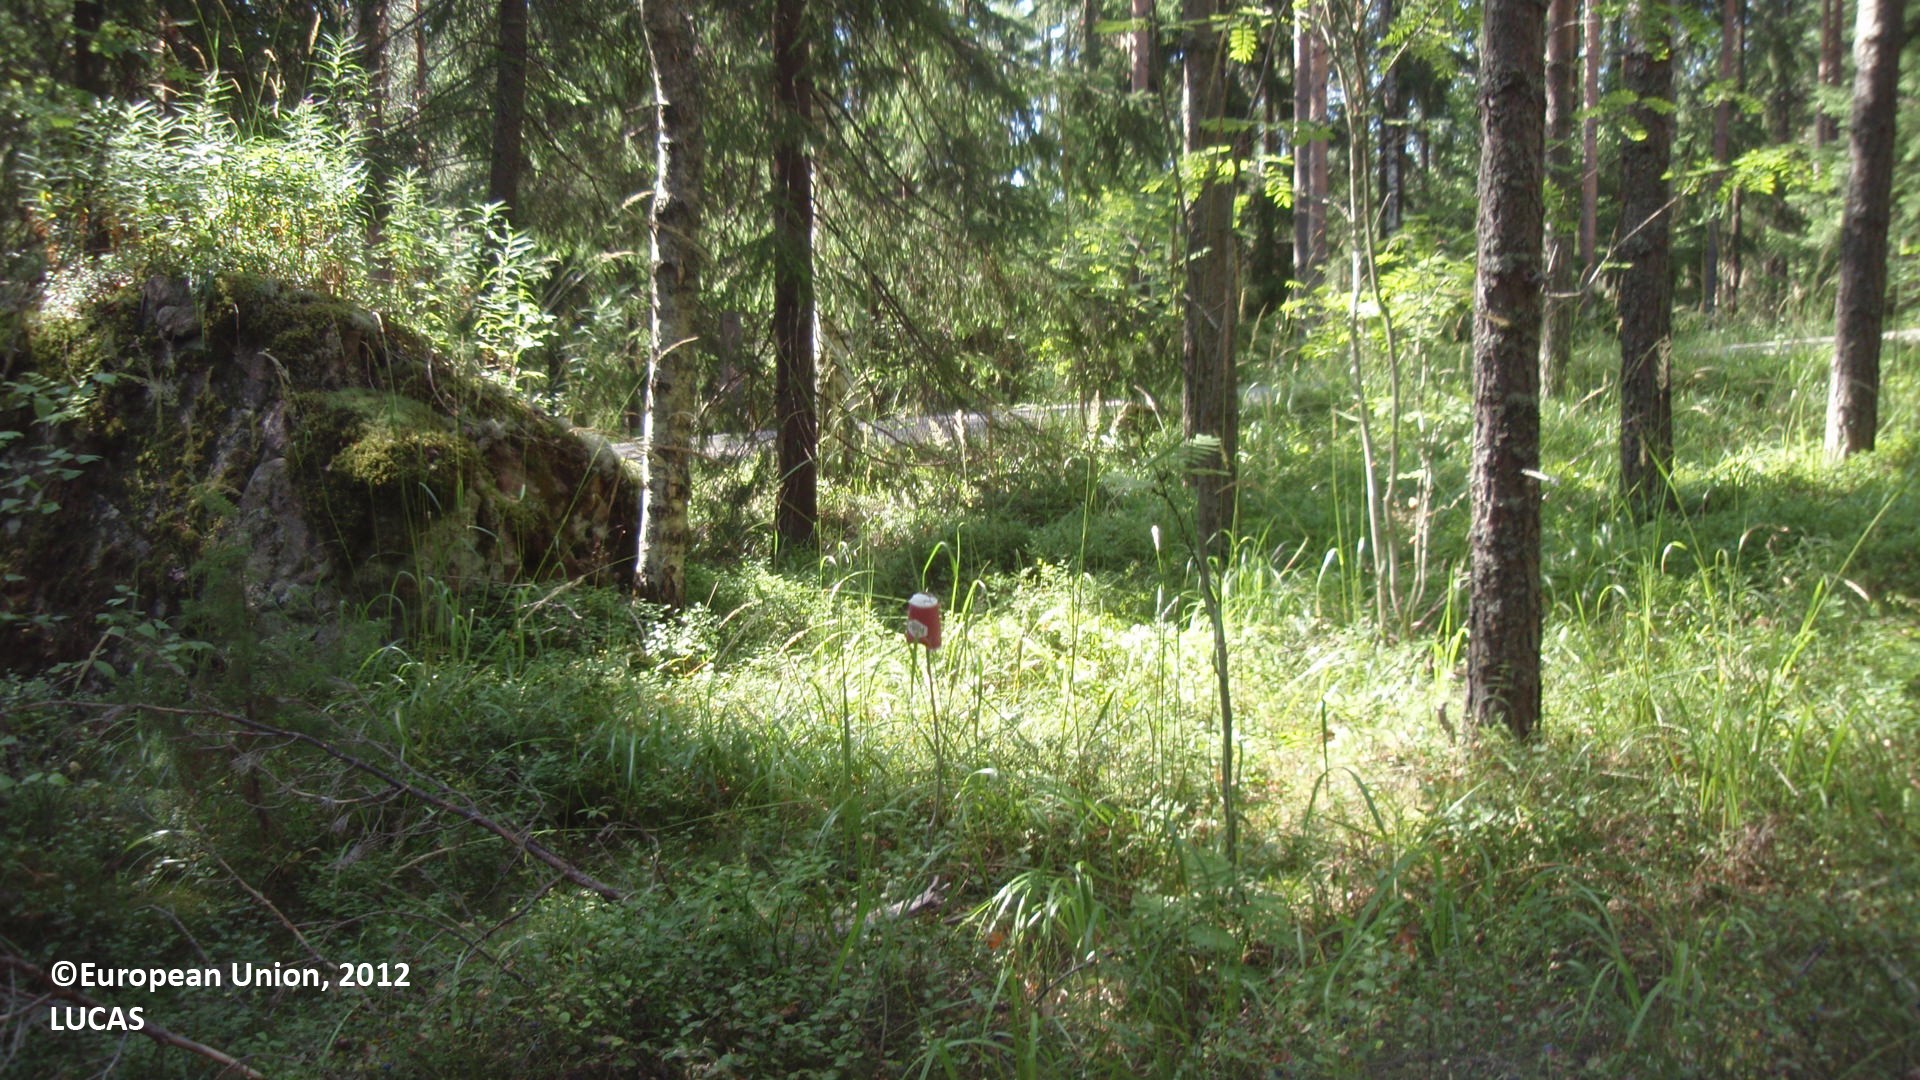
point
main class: Woodland
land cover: Pine dominated mixed woodland
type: boreal forest
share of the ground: 50 - 75 %
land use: Forestry
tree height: > 5 m
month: August
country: FI
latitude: 60.9998
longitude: 28.6578
